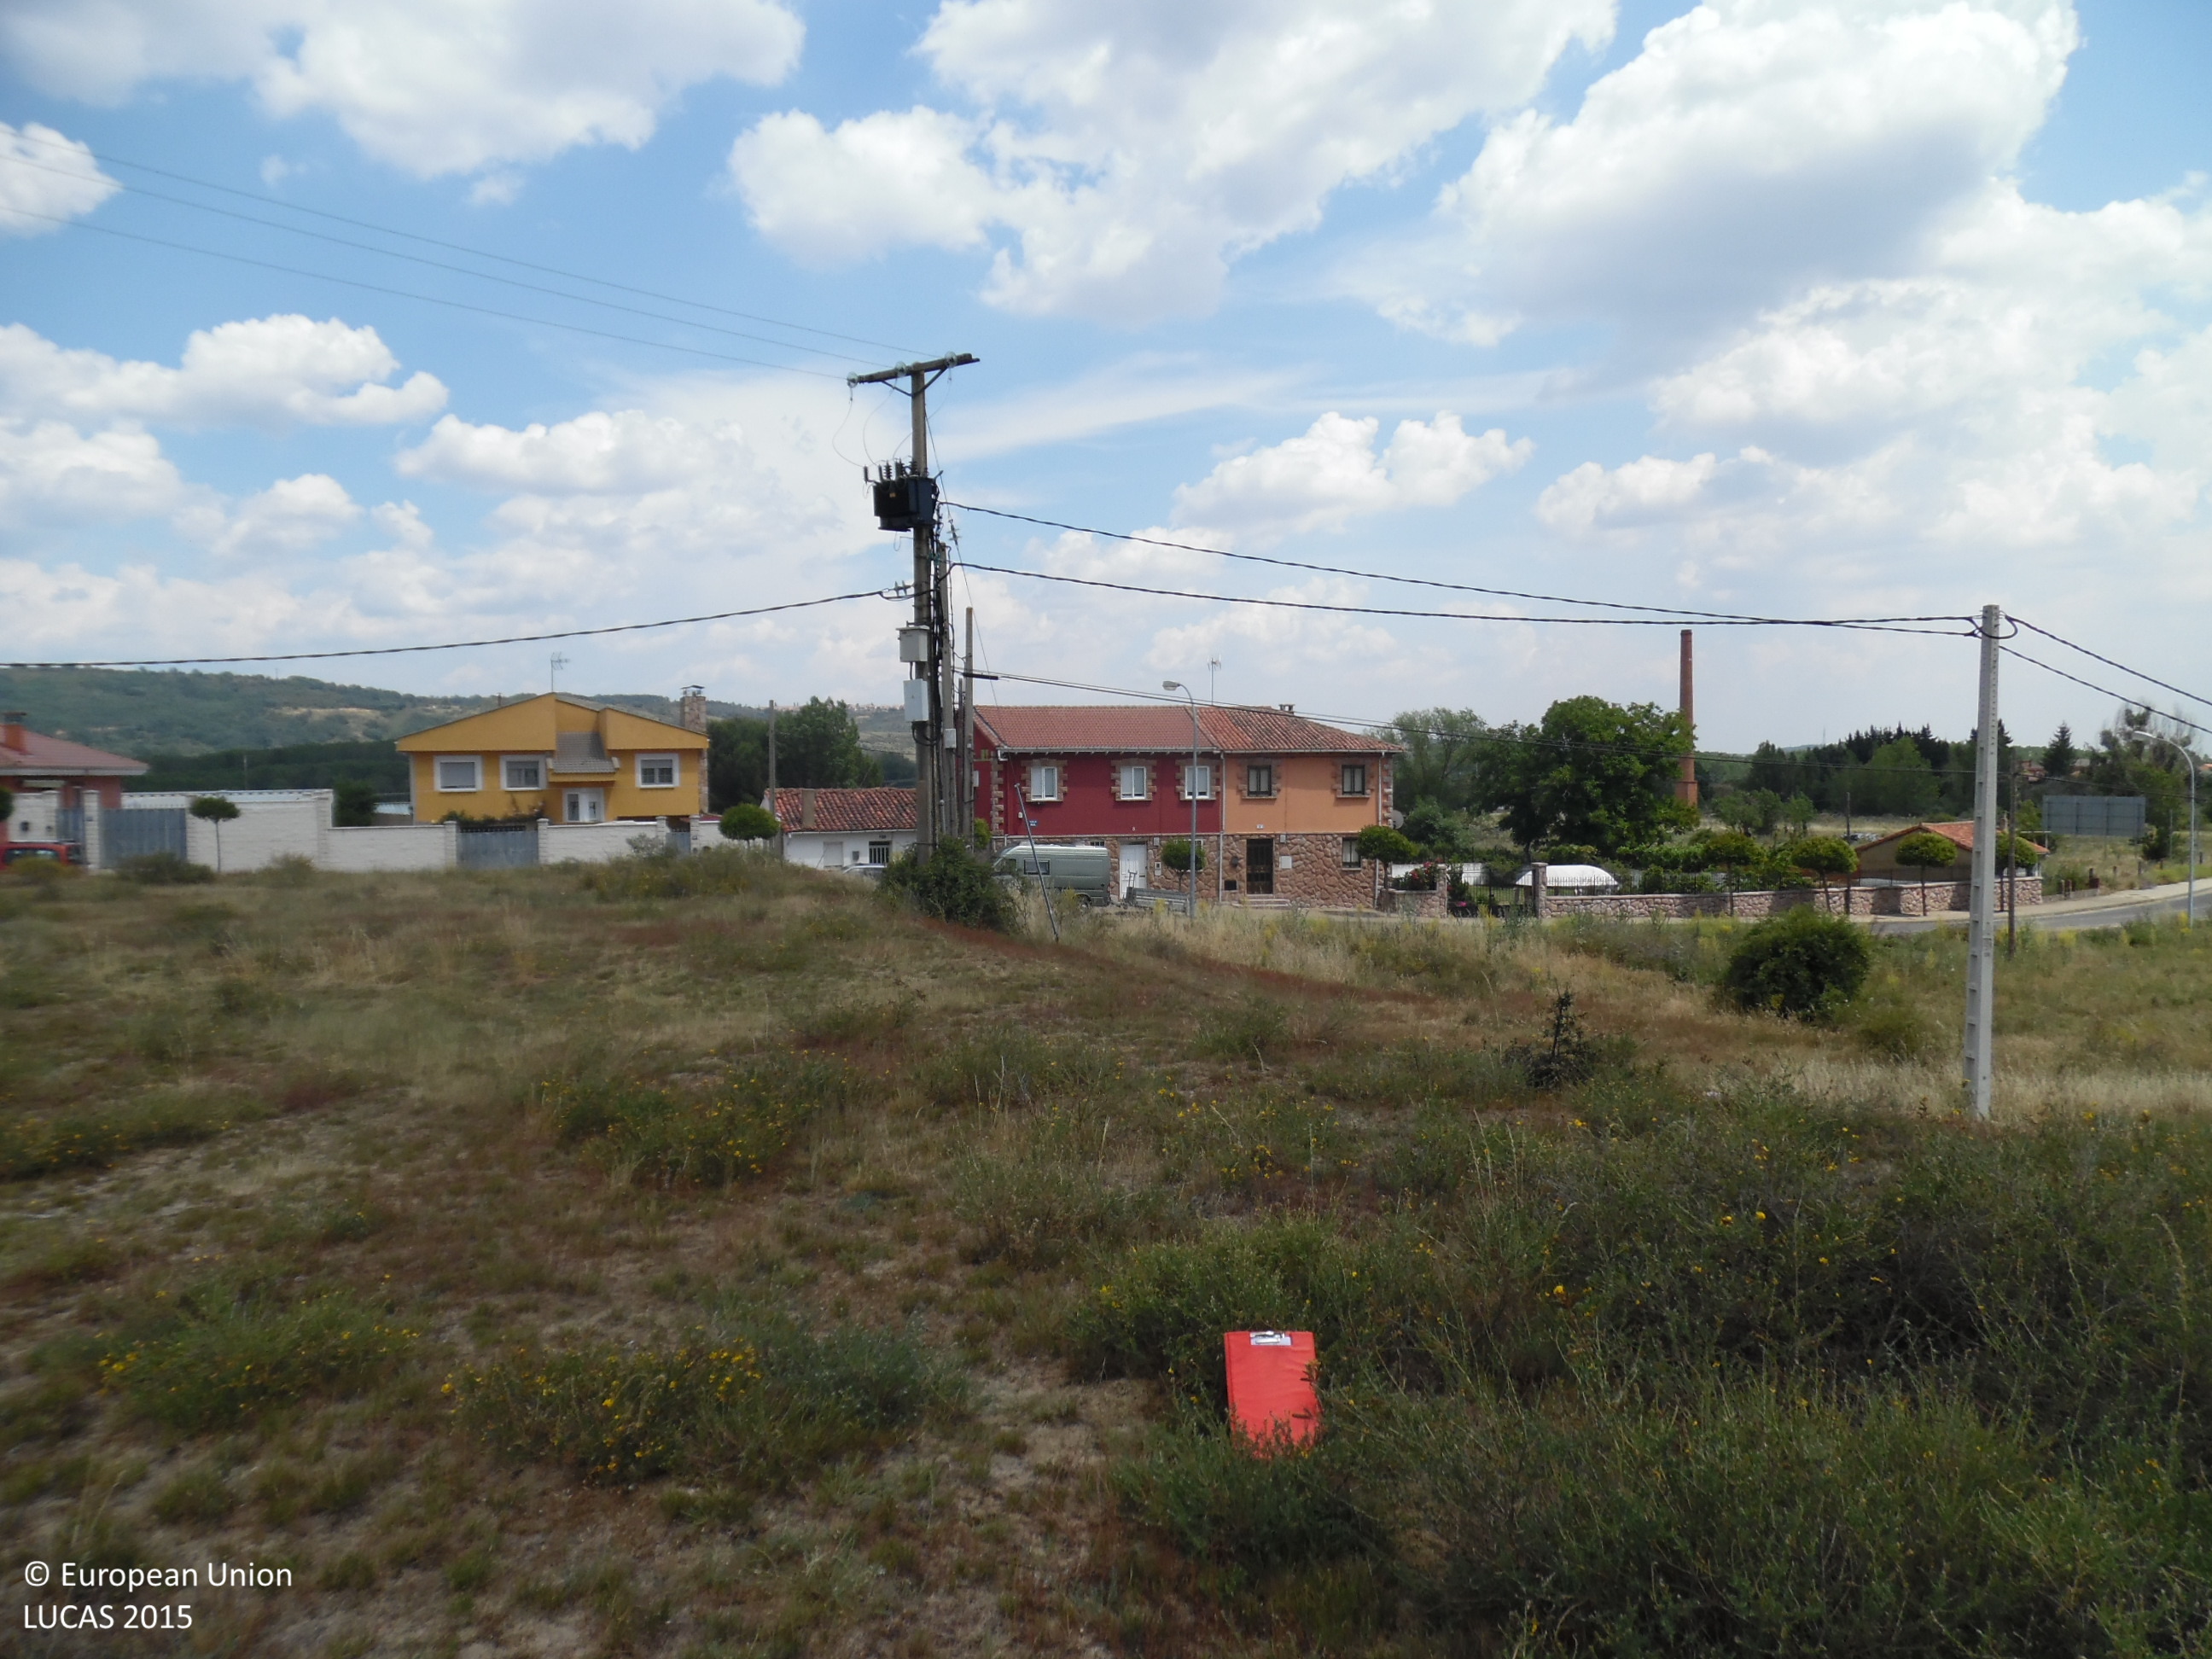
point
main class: Grassland
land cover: Grassland with sparse tree/shrub cover
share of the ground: > 75 %
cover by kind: herbaceous plants 95 %, broadleaved forest trees 5 %
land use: Agriculture (excluding fallow land and kitchen gardens)
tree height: < 5 m
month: June
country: ES
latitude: 42.6795
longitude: -5.6345
